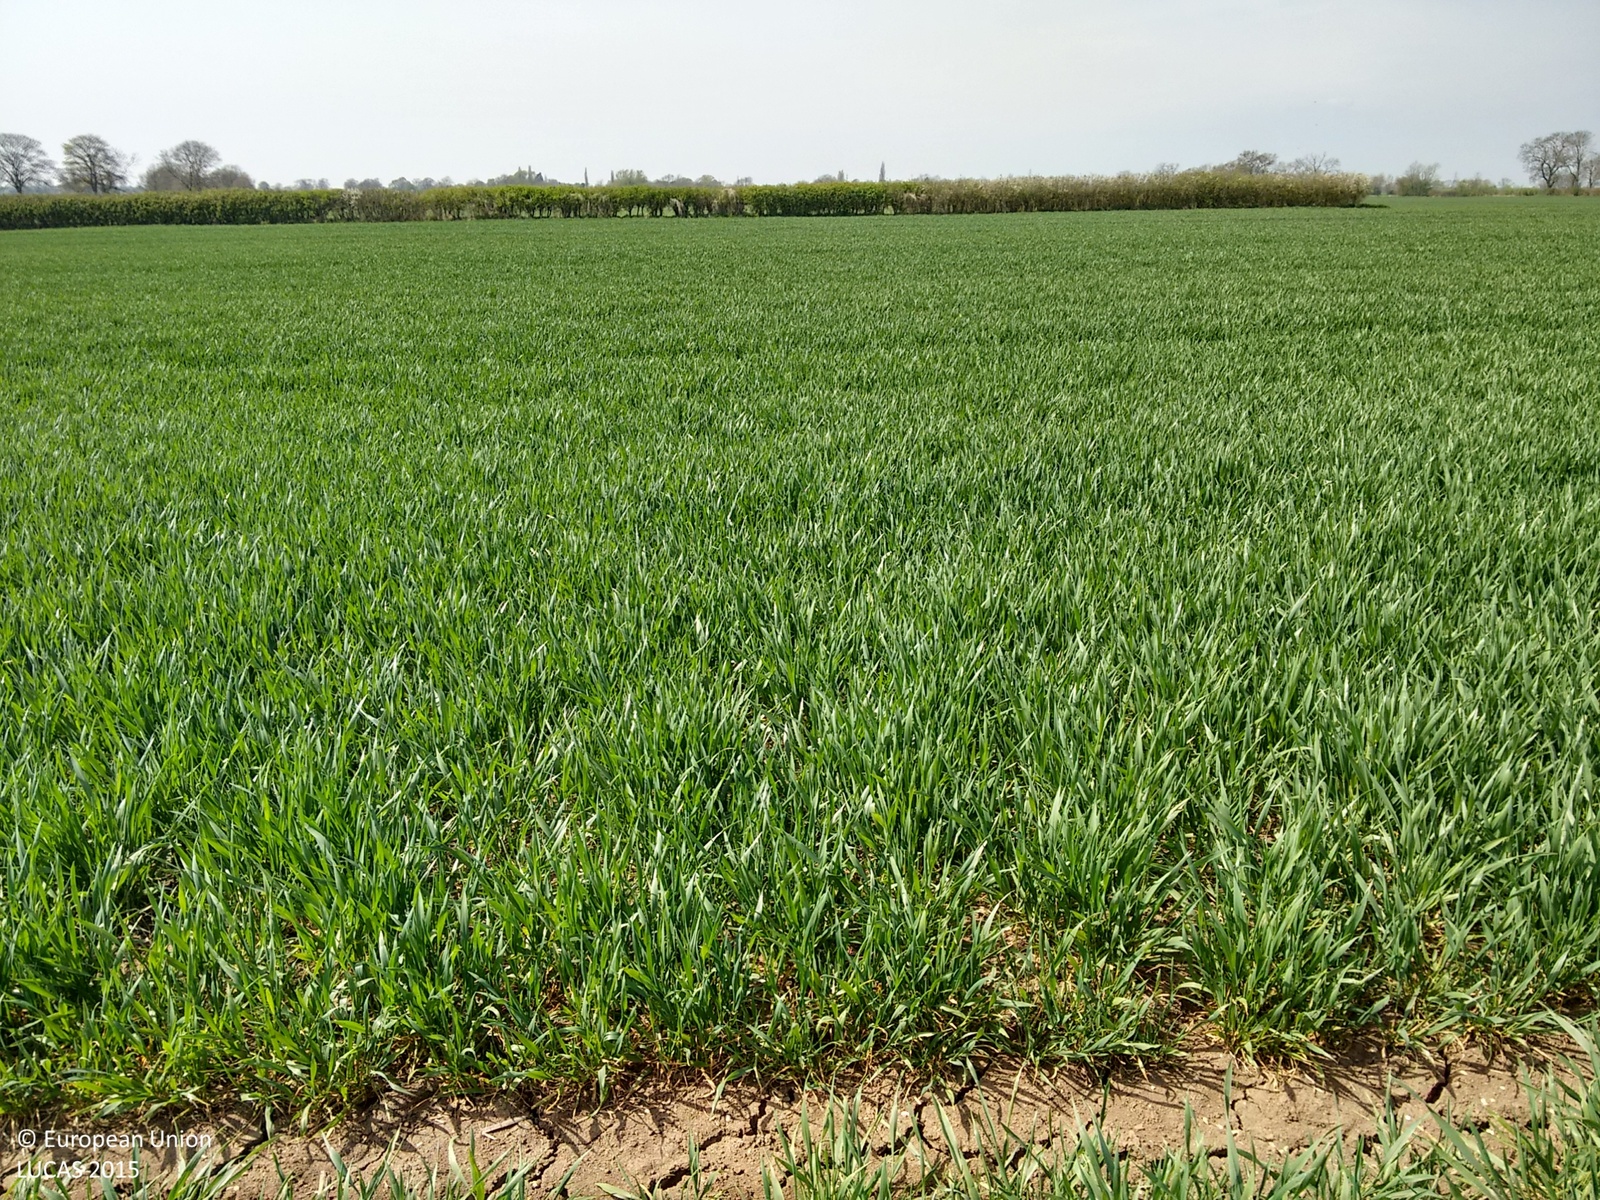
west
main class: Cropland
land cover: Barley
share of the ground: > 75 %
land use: Agriculture (excluding fallow land and kitchen gardens)
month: April
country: GB
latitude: 53.4360
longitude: -0.6818
